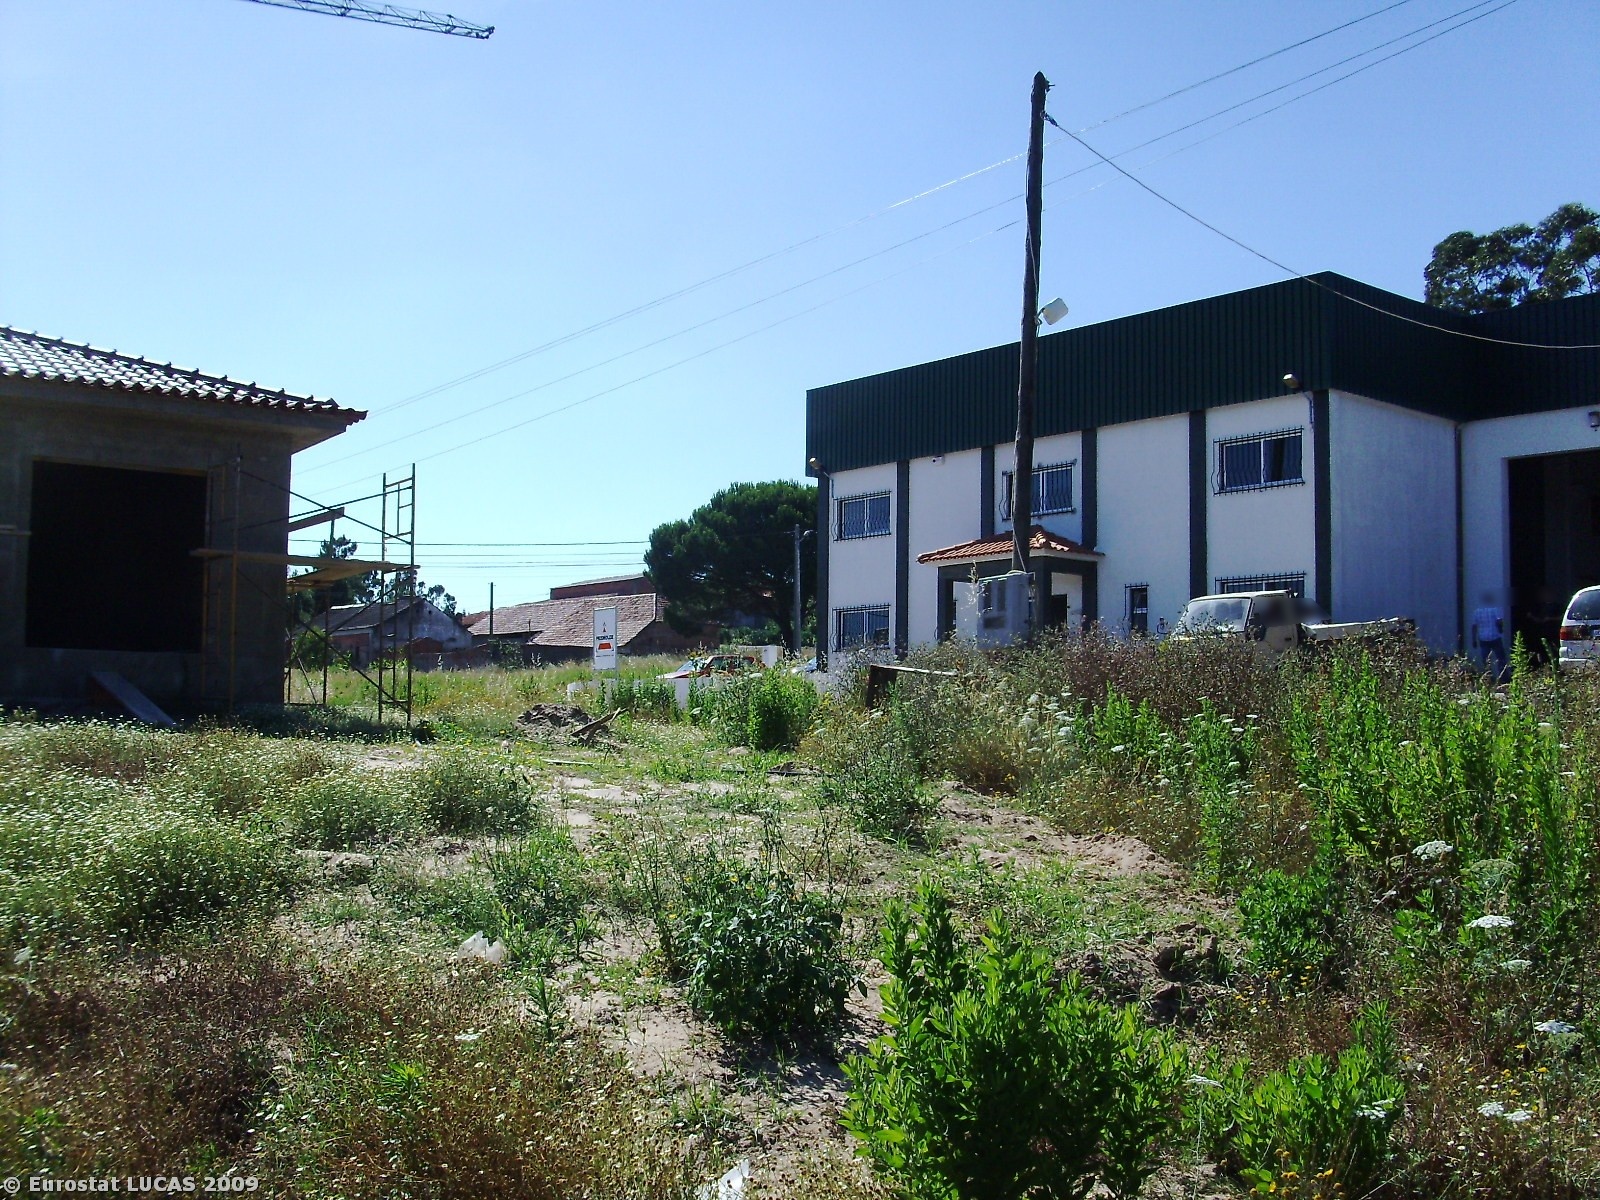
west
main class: Grassland
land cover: Spontaneously vegetated surfaces
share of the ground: > 75 %
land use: Fallow land
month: July
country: PT
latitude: 39.6810
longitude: -8.9415
